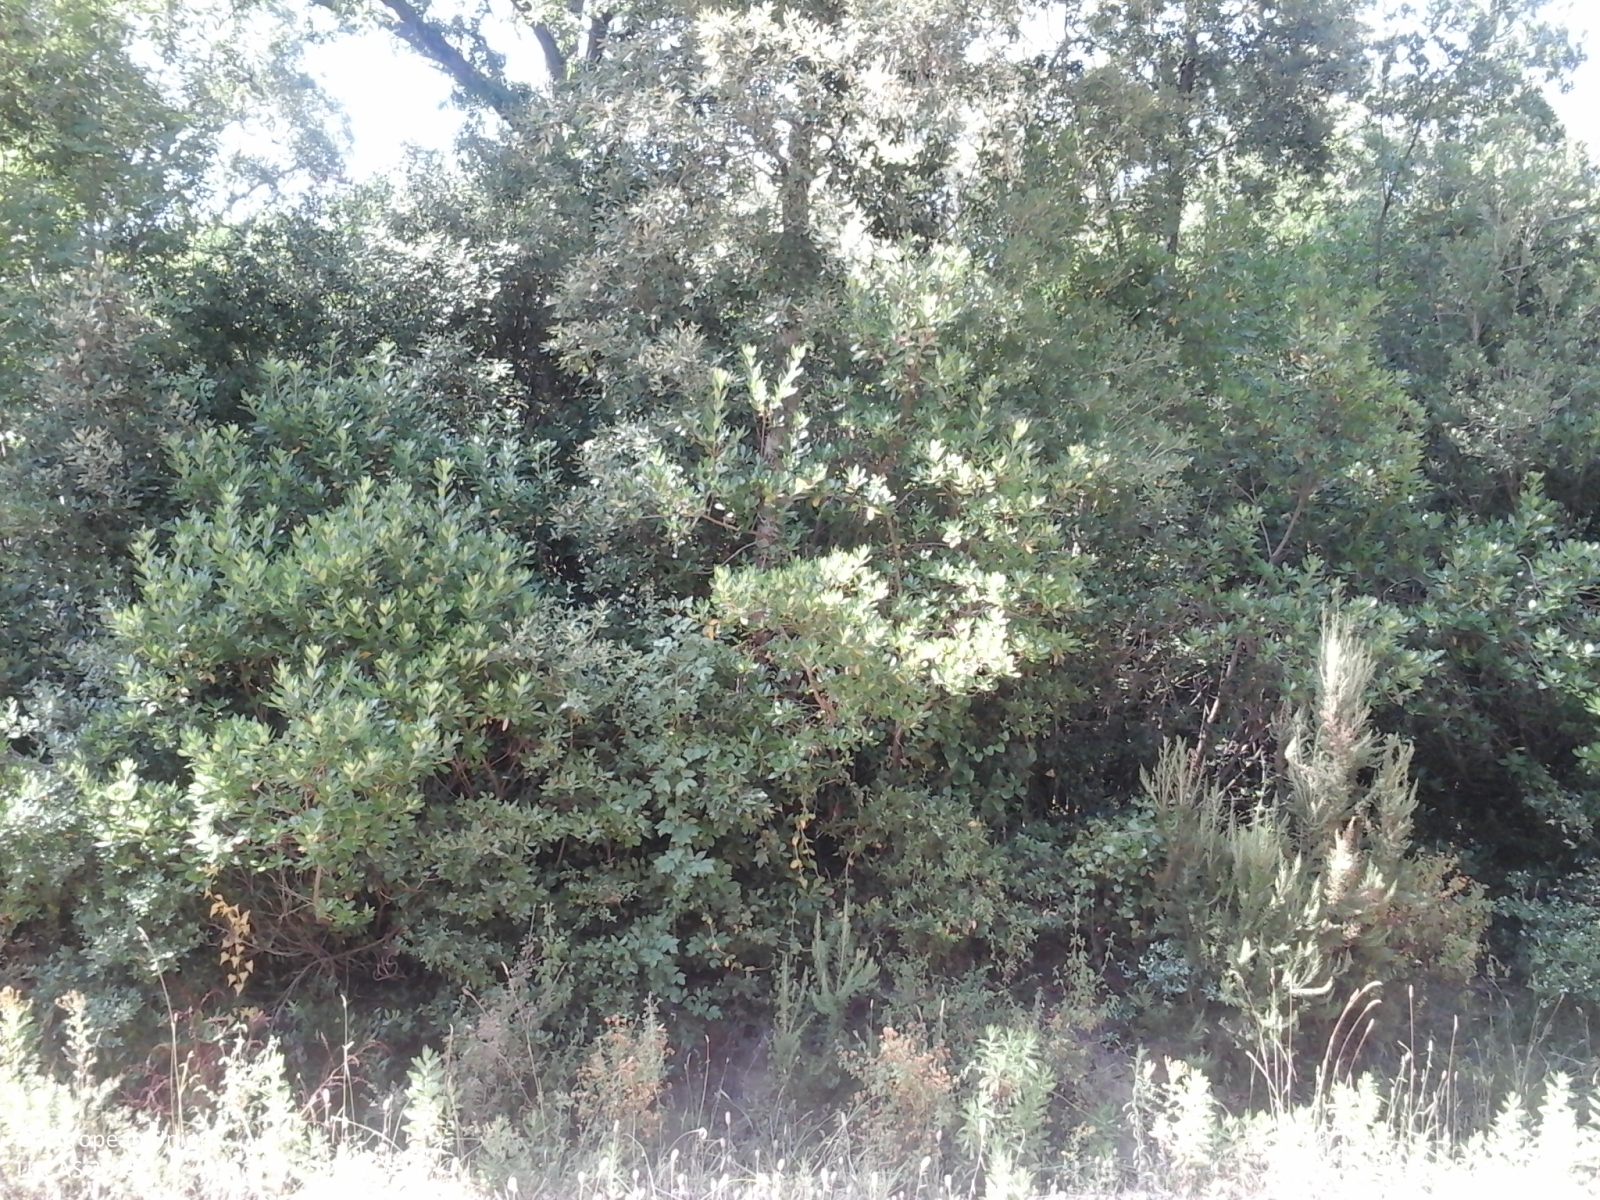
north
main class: Woodland
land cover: Broadleaved woodland
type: broadleaved evergreen forest
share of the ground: > 75 %
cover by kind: broadleaved forest trees 100 %
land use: Forestry
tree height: > 5 m
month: July
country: IT
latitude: 42.8668
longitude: 10.8907
